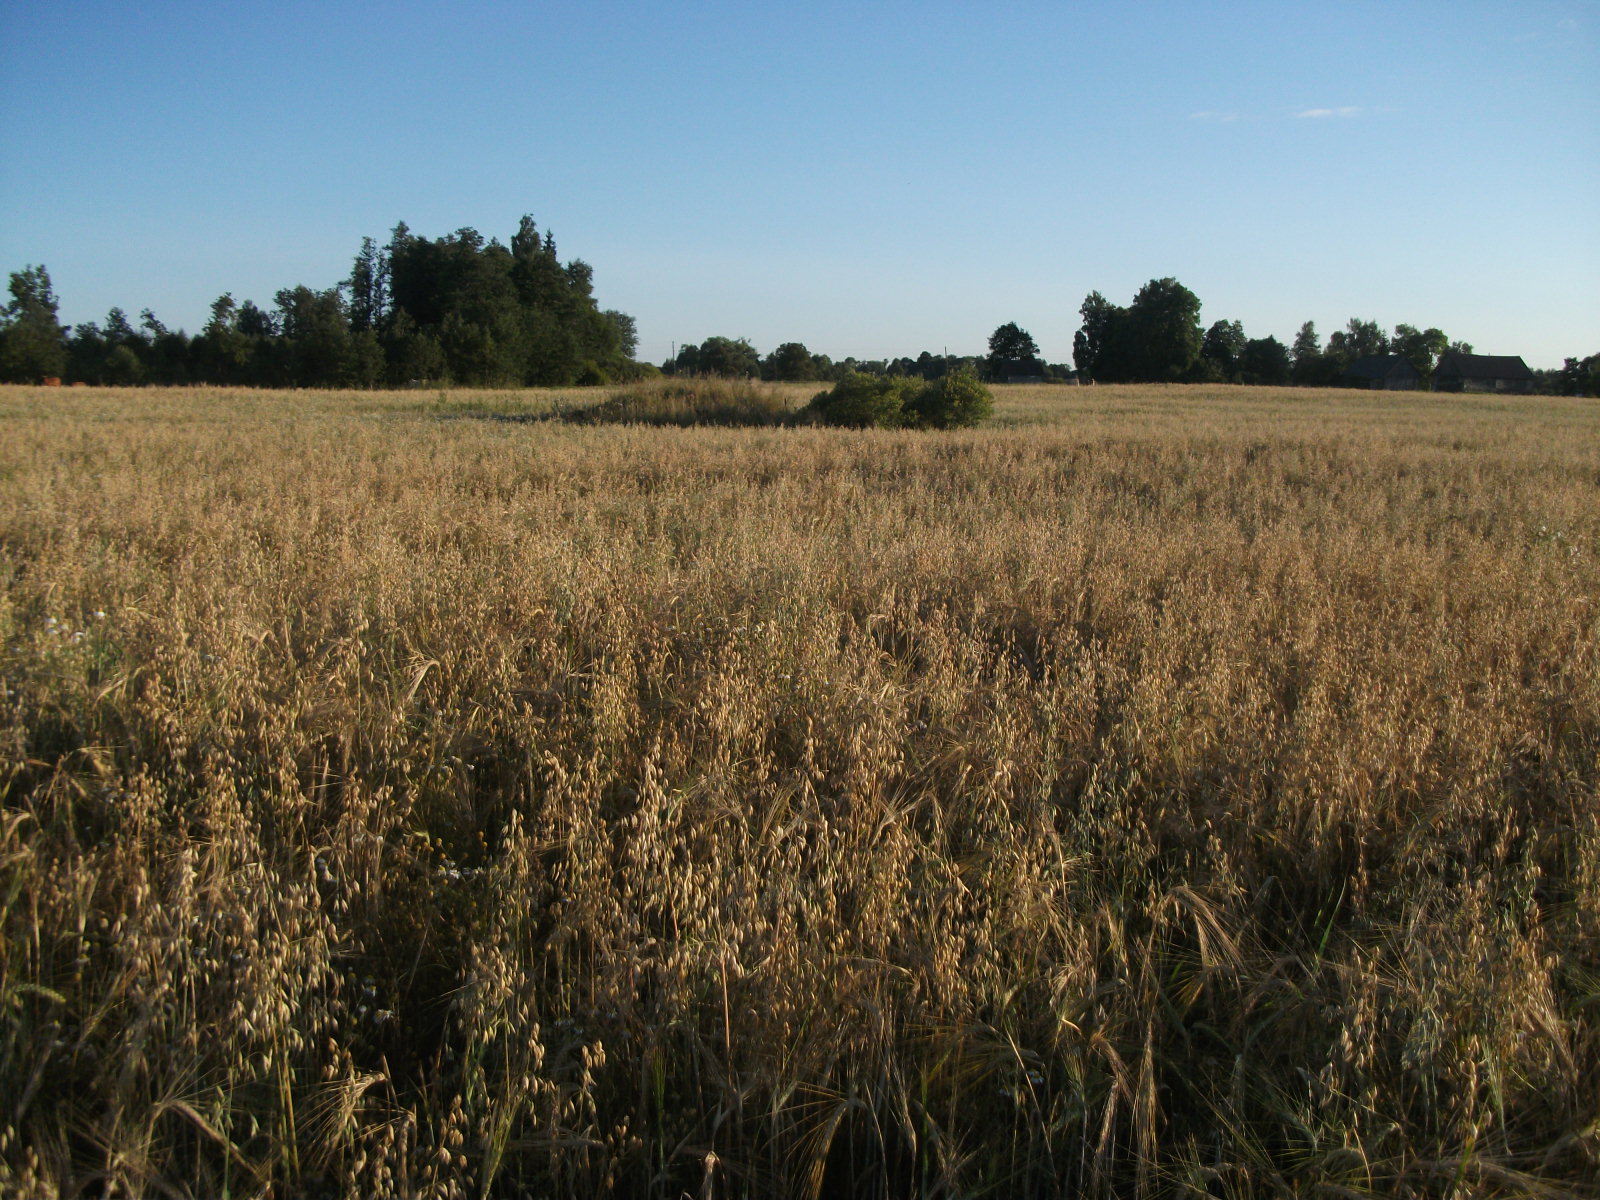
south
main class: Cropland
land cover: Mixed cereals for fodder
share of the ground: 50 - 75 %
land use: Agriculture (excluding fallow land and kitchen gardens)
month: August
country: LV
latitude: 56.3397
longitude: 26.3704
